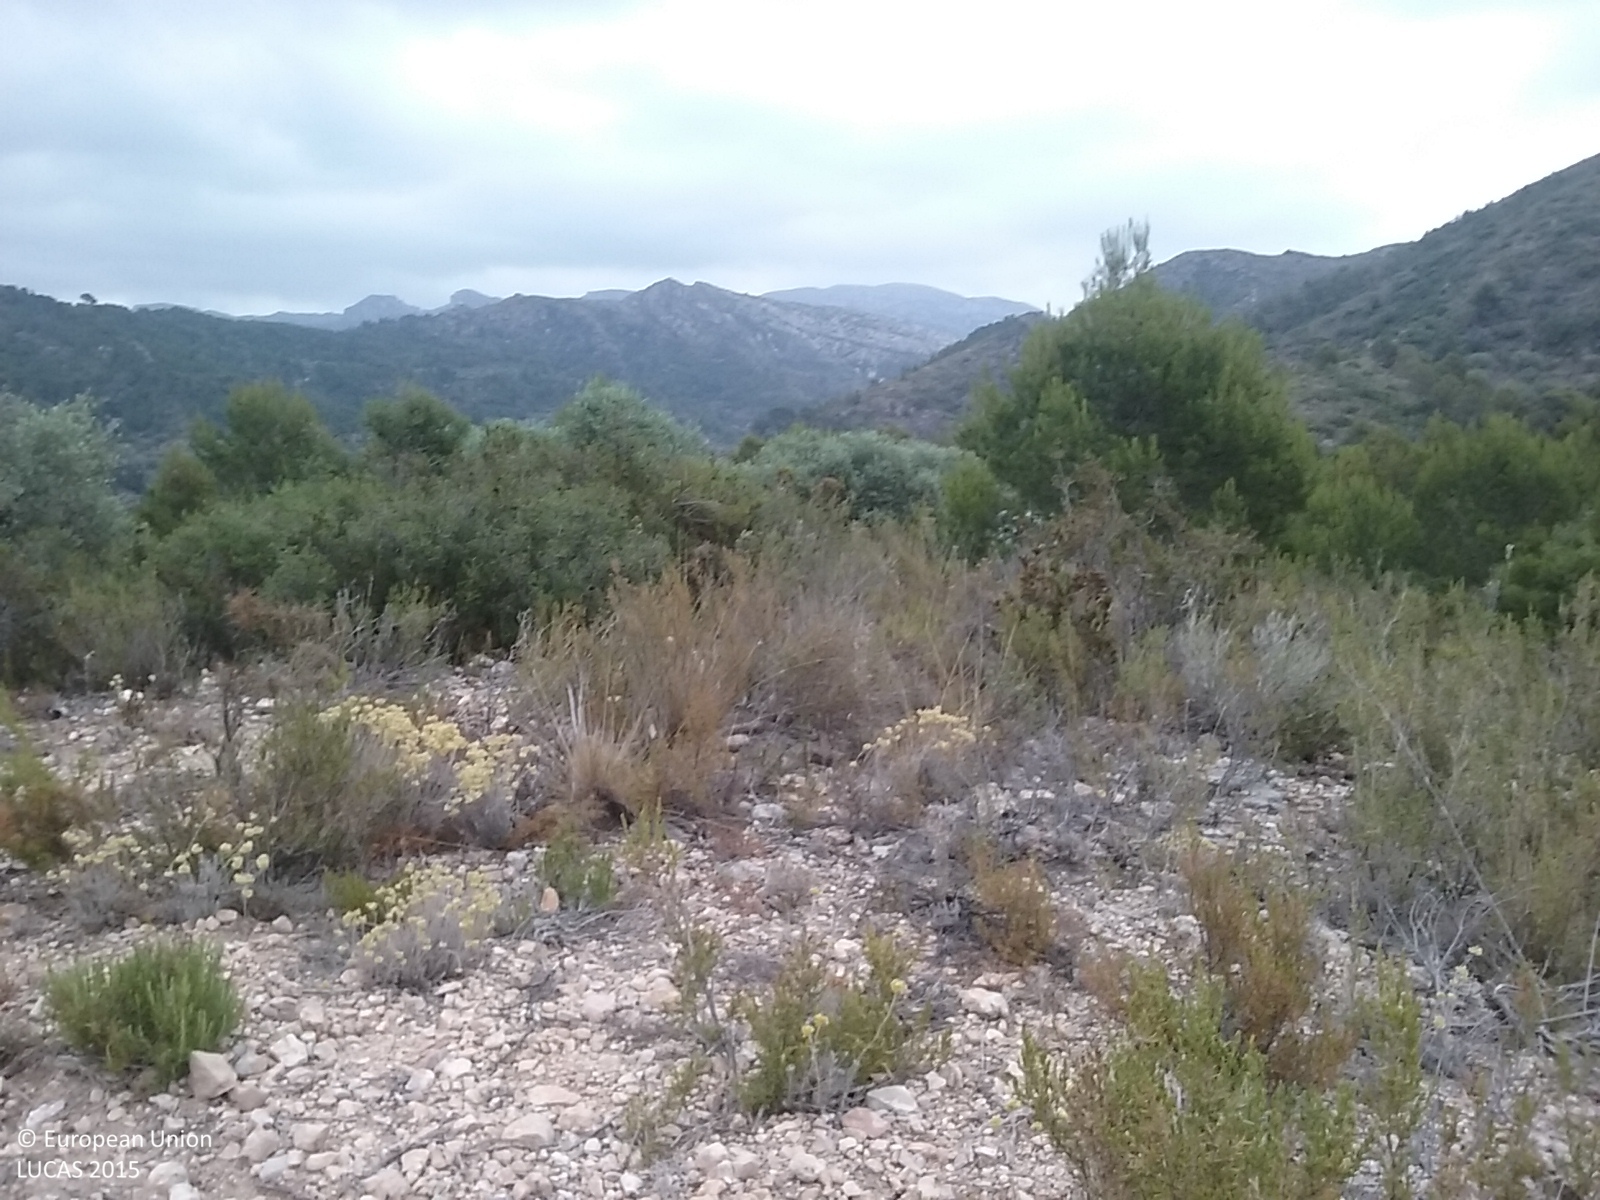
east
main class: Shrubland
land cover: Shrubland with sparse tree cover
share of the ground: 25 - 50 %
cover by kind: shrubs 50 %, unconsolidated bare surface 45 %, coniferous forest trees 5 %
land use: Semi-natural and natural areas not in use
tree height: < 5 m
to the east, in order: Shrubland with sparse tree cover; Dry stone walls; Olive groves; Dry stone walls; Olive groves; Dry stone walls; Olive groves; Dry stone walls; Olive groves; Dry stone walls; Olive groves; Dry stone walls; Olive groves; Dry stone walls; Olive groves; Pine dominated coniferous woodland
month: June
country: ES
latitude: 40.8848
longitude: 0.5584
